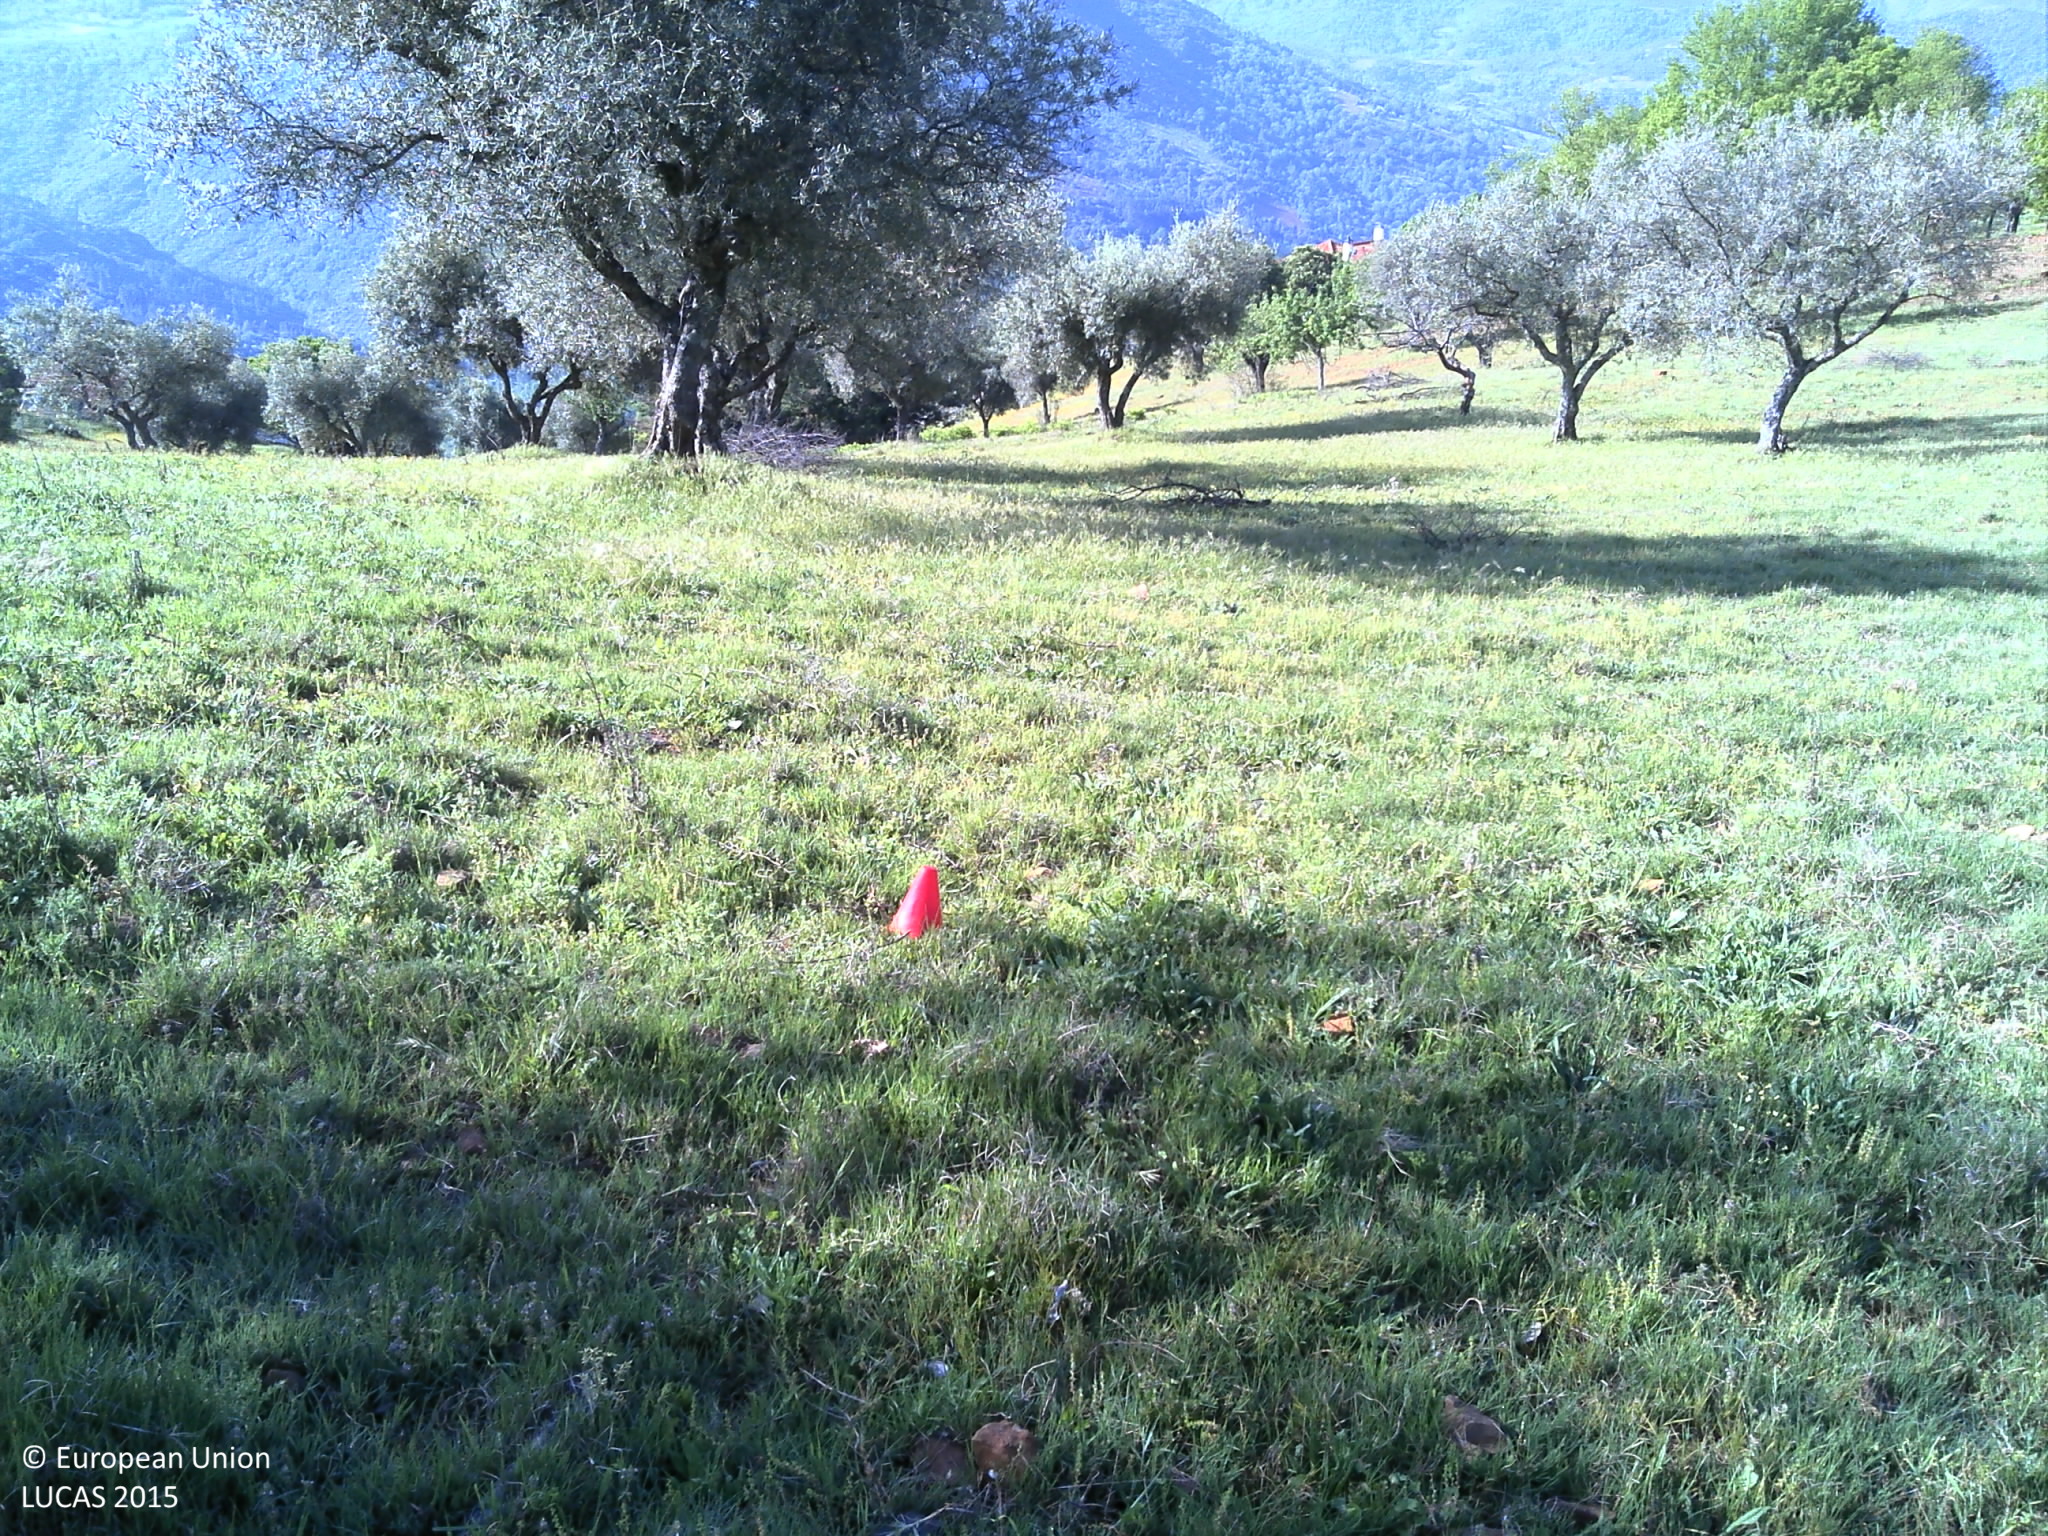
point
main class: Cropland
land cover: Olive groves
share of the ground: 10 - 25 %
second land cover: Grassland without tree/shrub cover
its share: 50 - 75 %
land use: Agriculture (excluding fallow land and kitchen gardens)
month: May
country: PT
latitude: 41.8325
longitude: -6.9890
